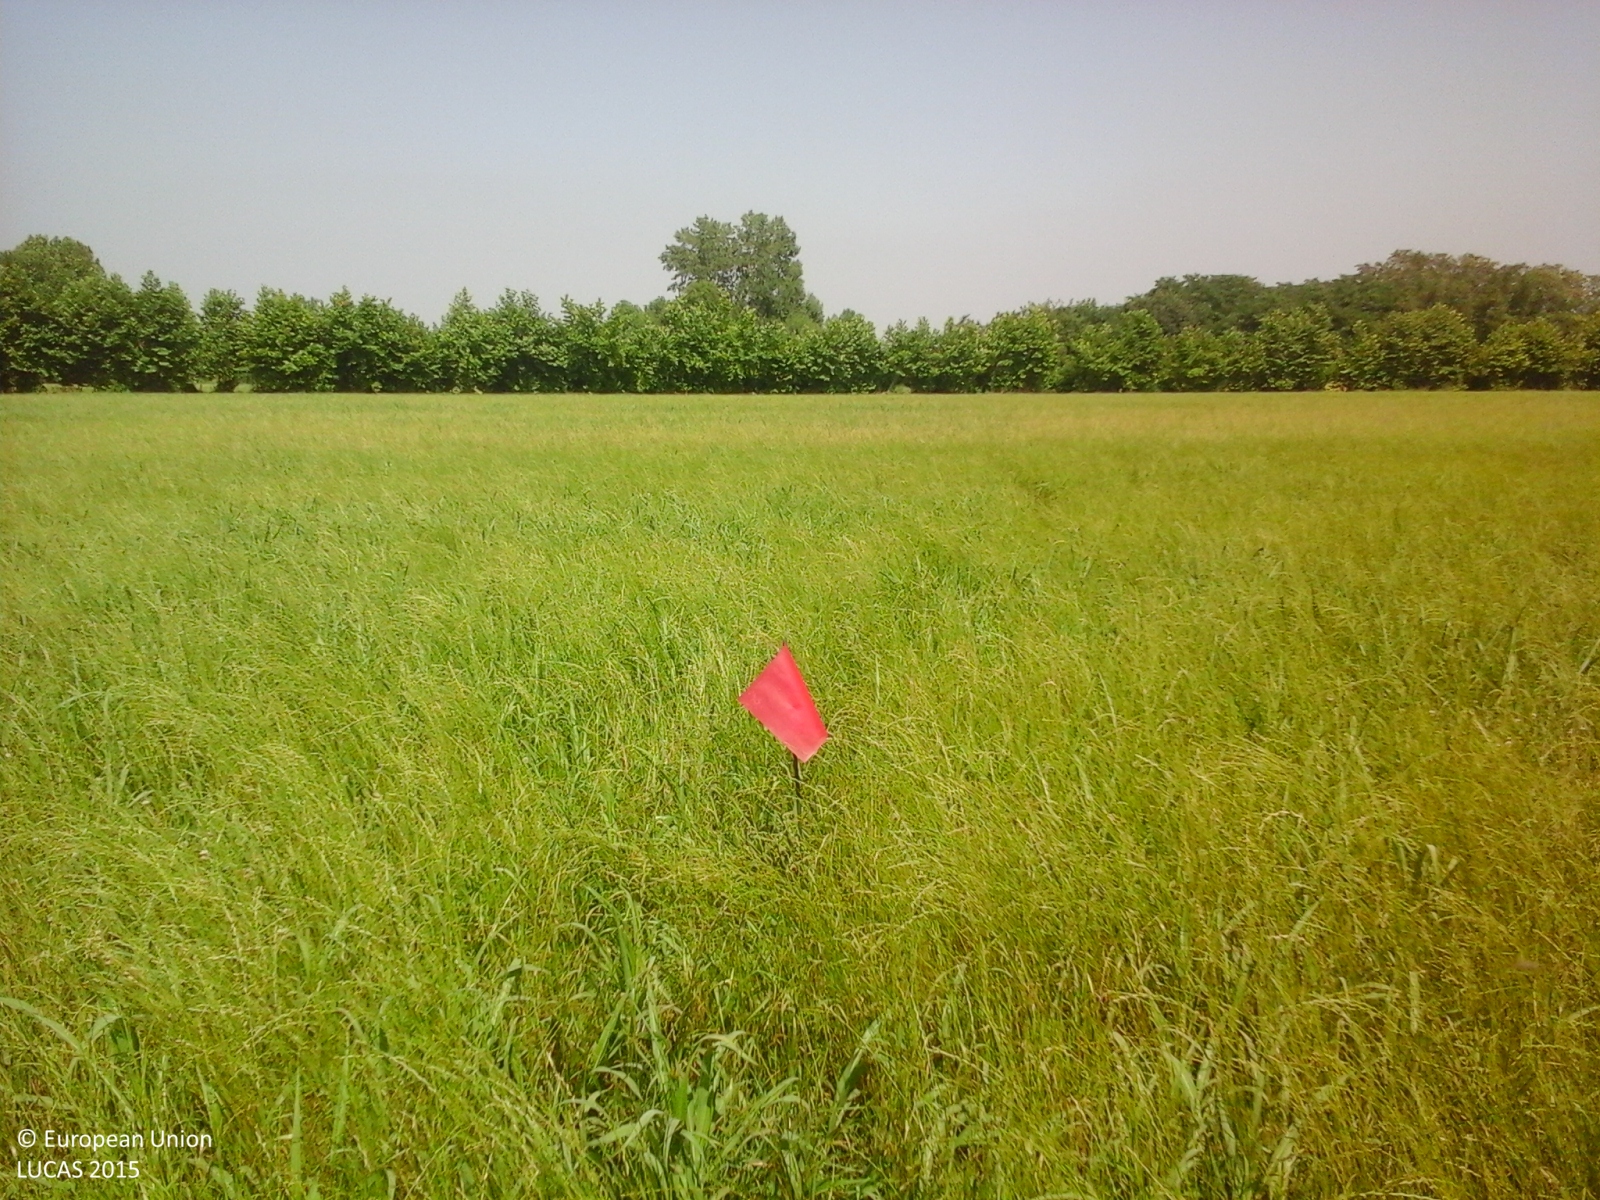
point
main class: Cropland
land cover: Temporary grasslands
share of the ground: > 75 %
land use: Agriculture (excluding fallow land and kitchen gardens)
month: July
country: IT
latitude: 45.2676
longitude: 10.7252
